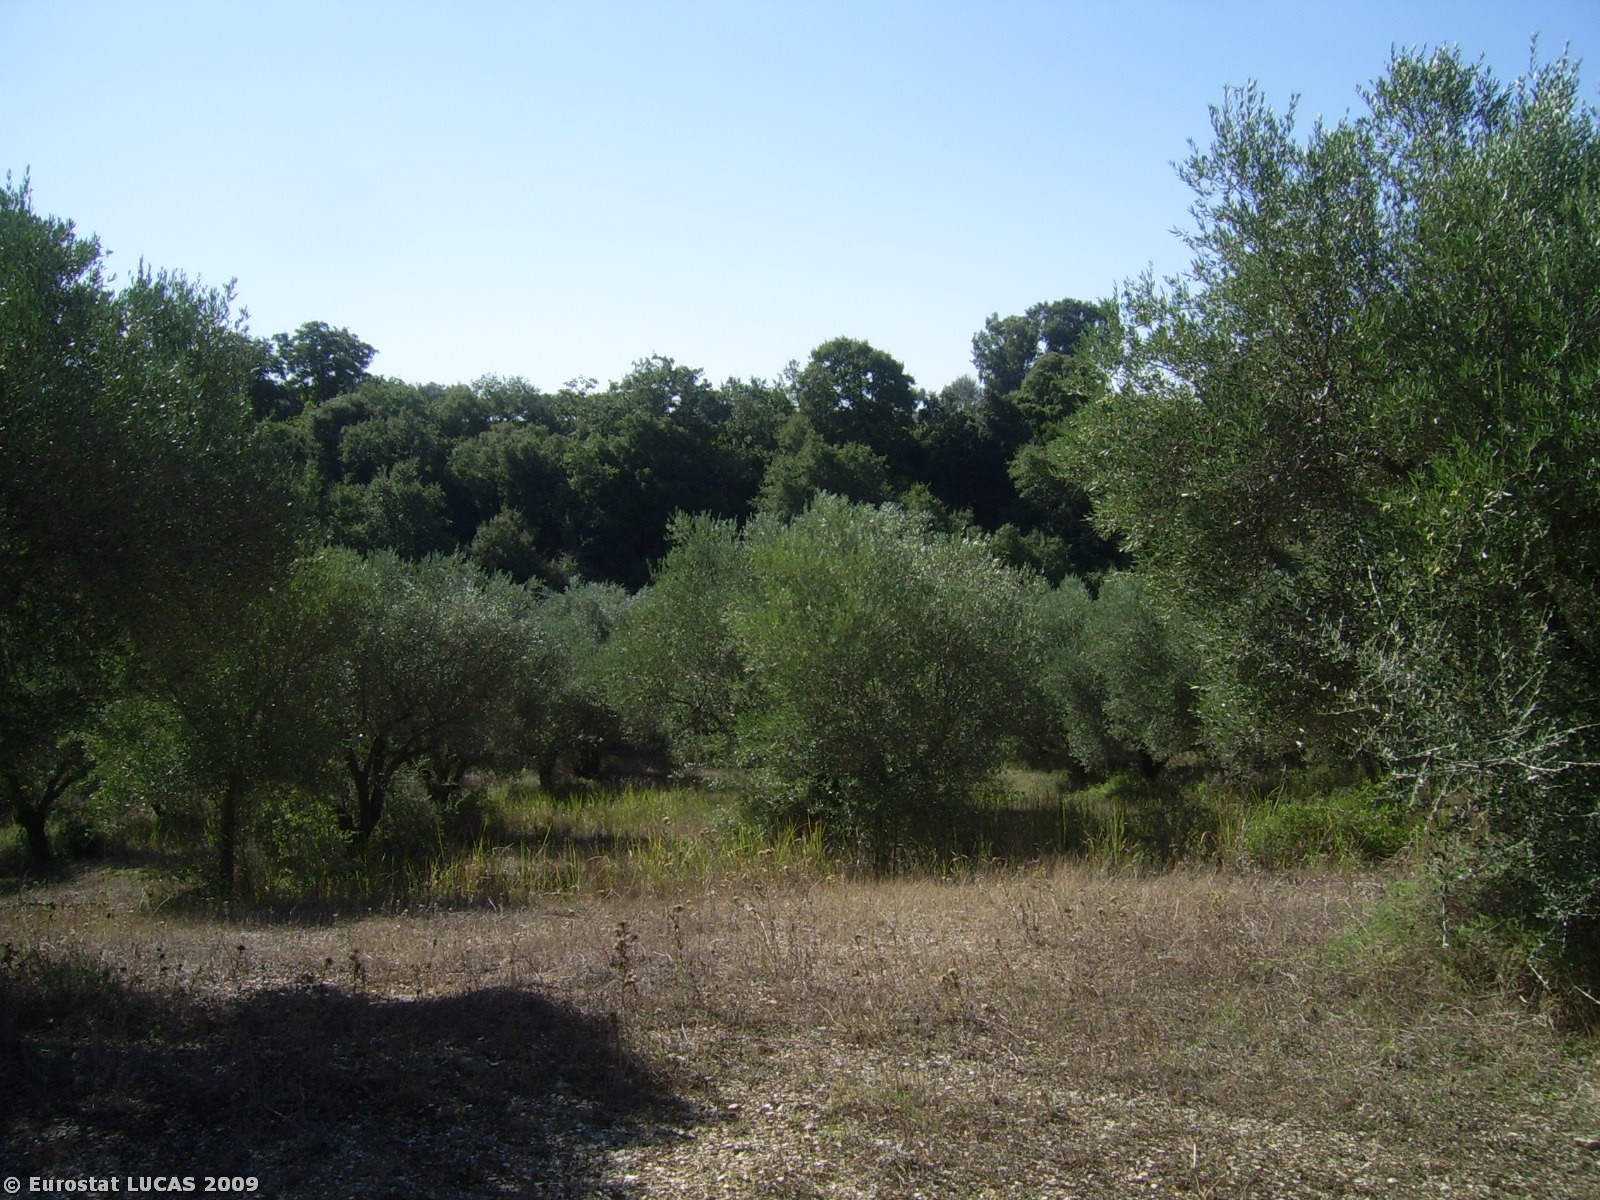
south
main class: Cropland
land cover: Olive groves
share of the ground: 50 - 75 %
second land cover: Grassland with sparse tree/shrub cover
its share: 50 - 75 %
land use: Agriculture (excluding fallow land and kitchen gardens)
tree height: > 5 m
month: October
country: GR
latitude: 37.9892
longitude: 21.4285
